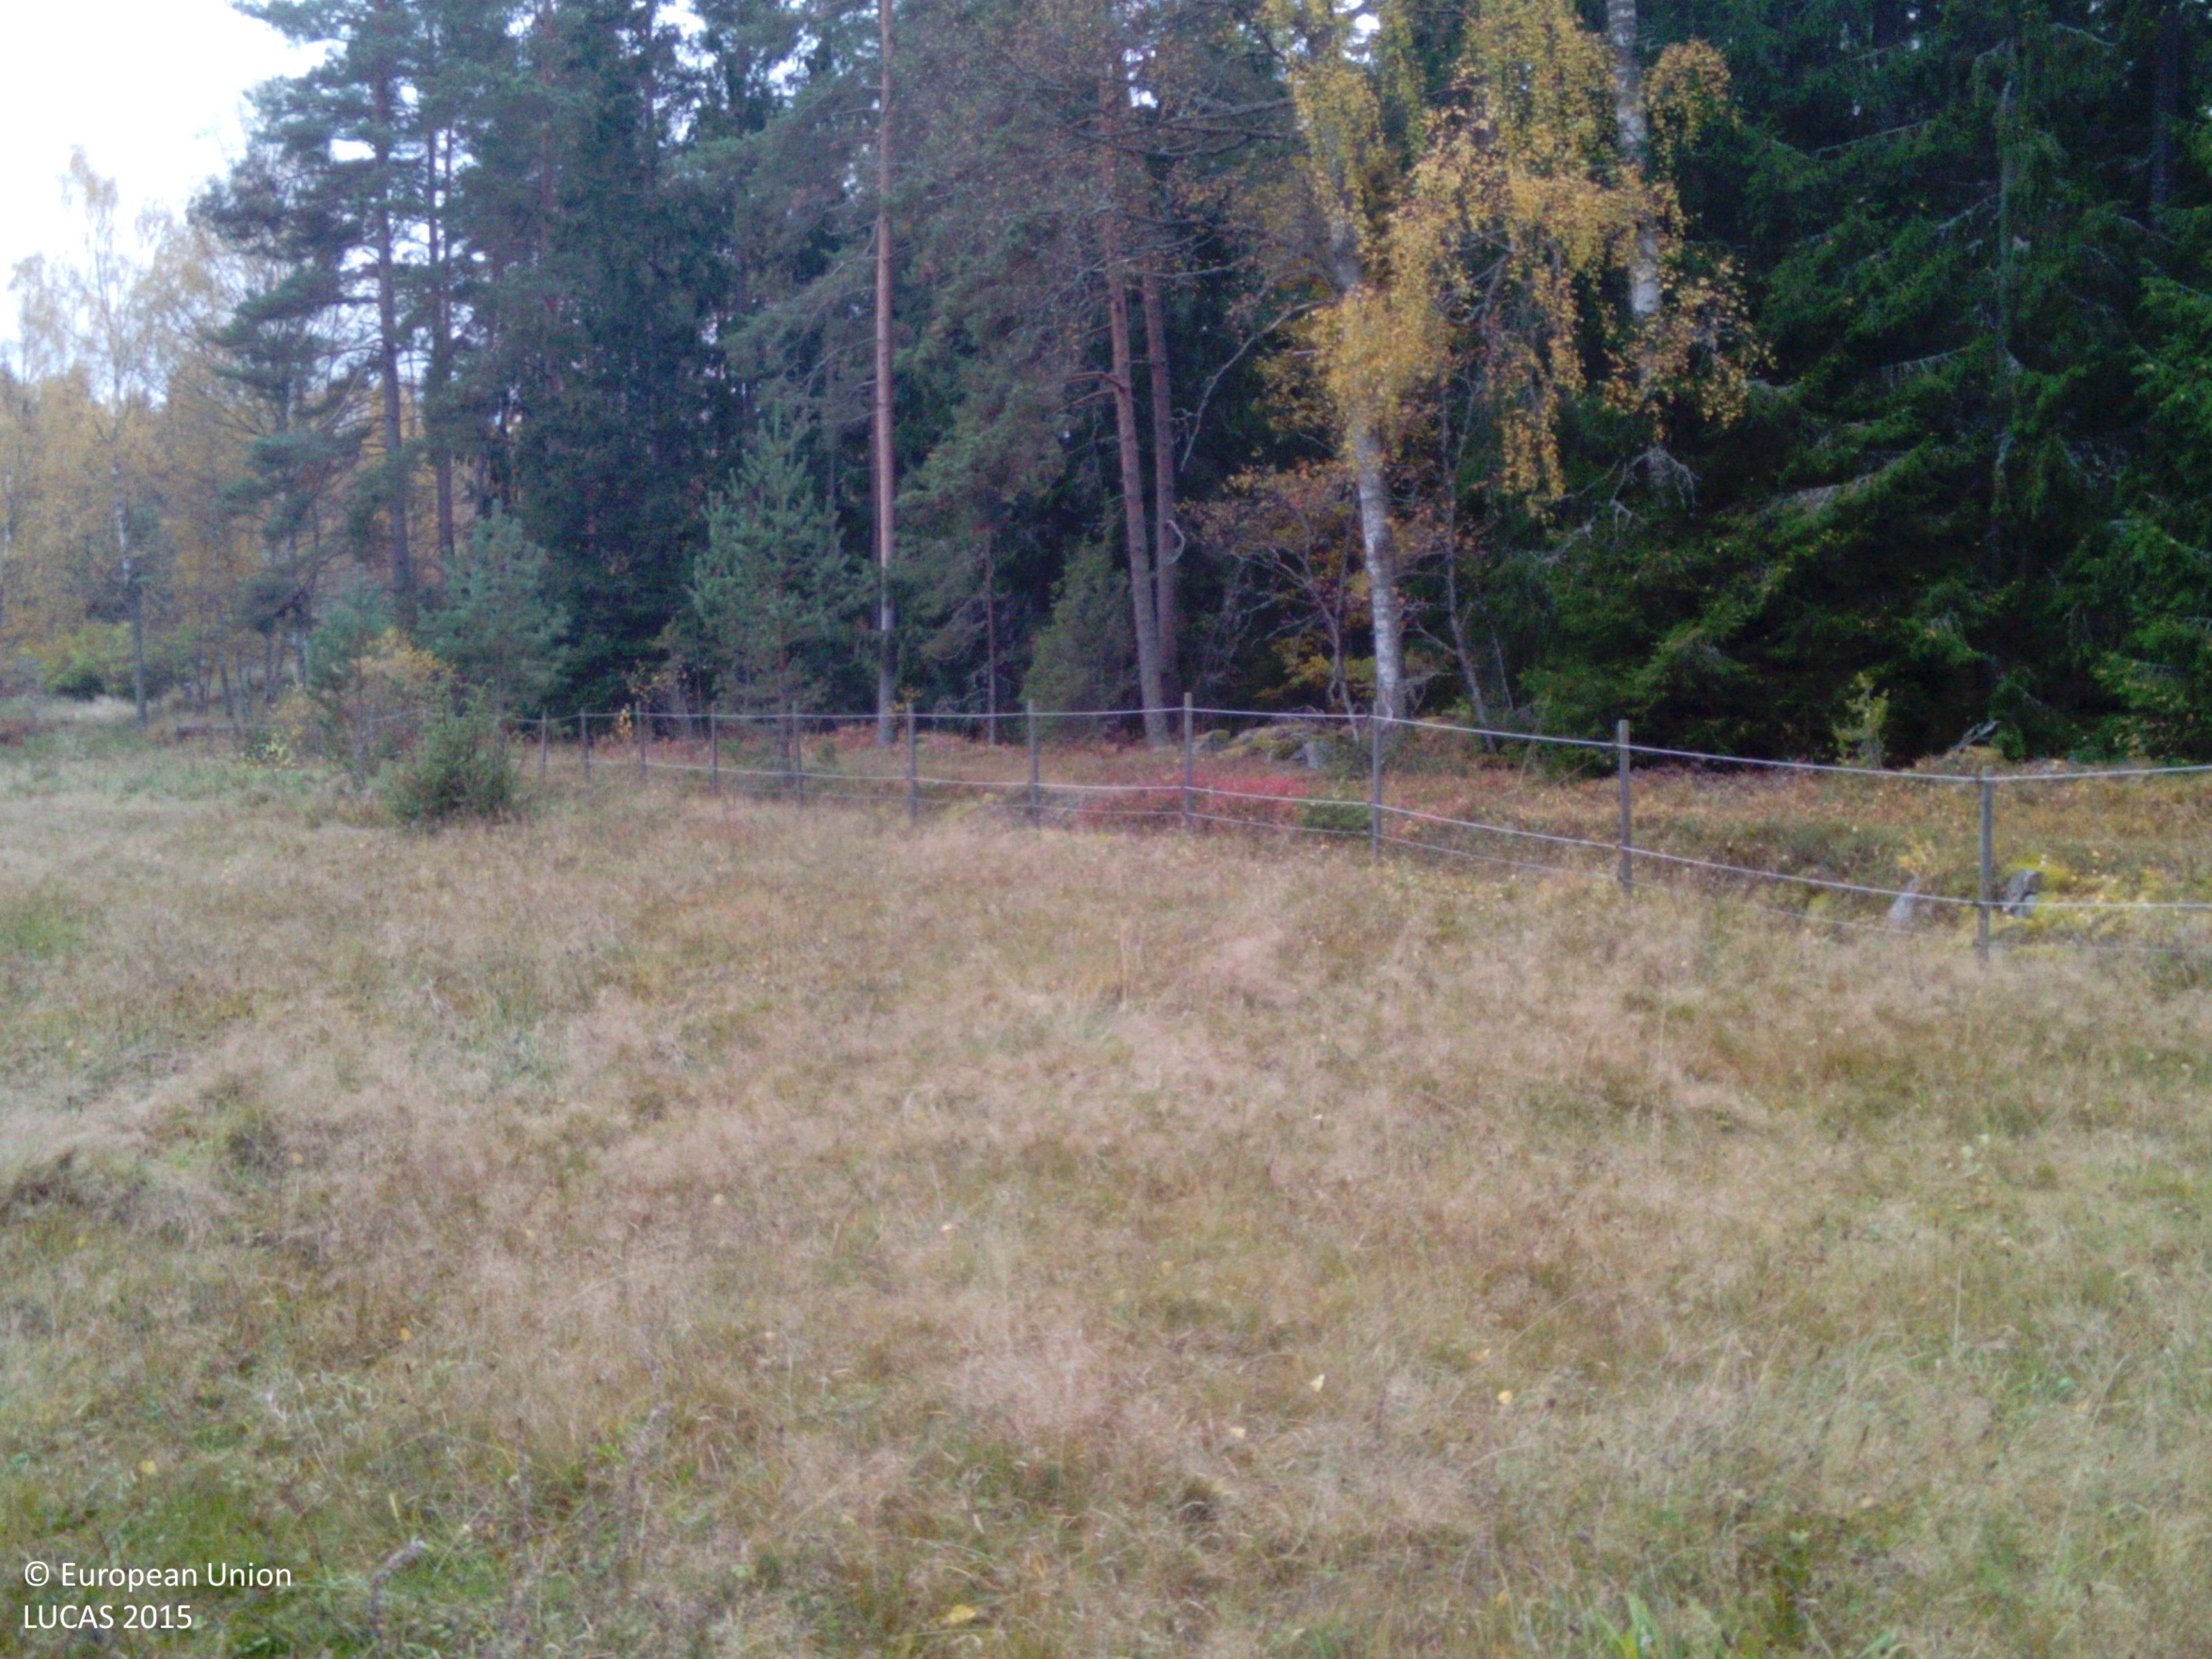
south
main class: Grassland
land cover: Grassland without tree/shrub cover
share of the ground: > 75 %
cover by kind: herbaceous plants 100 %
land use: Agriculture (excluding fallow land and kitchen gardens)
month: October
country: SE
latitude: 59.2474
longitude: 16.2524
